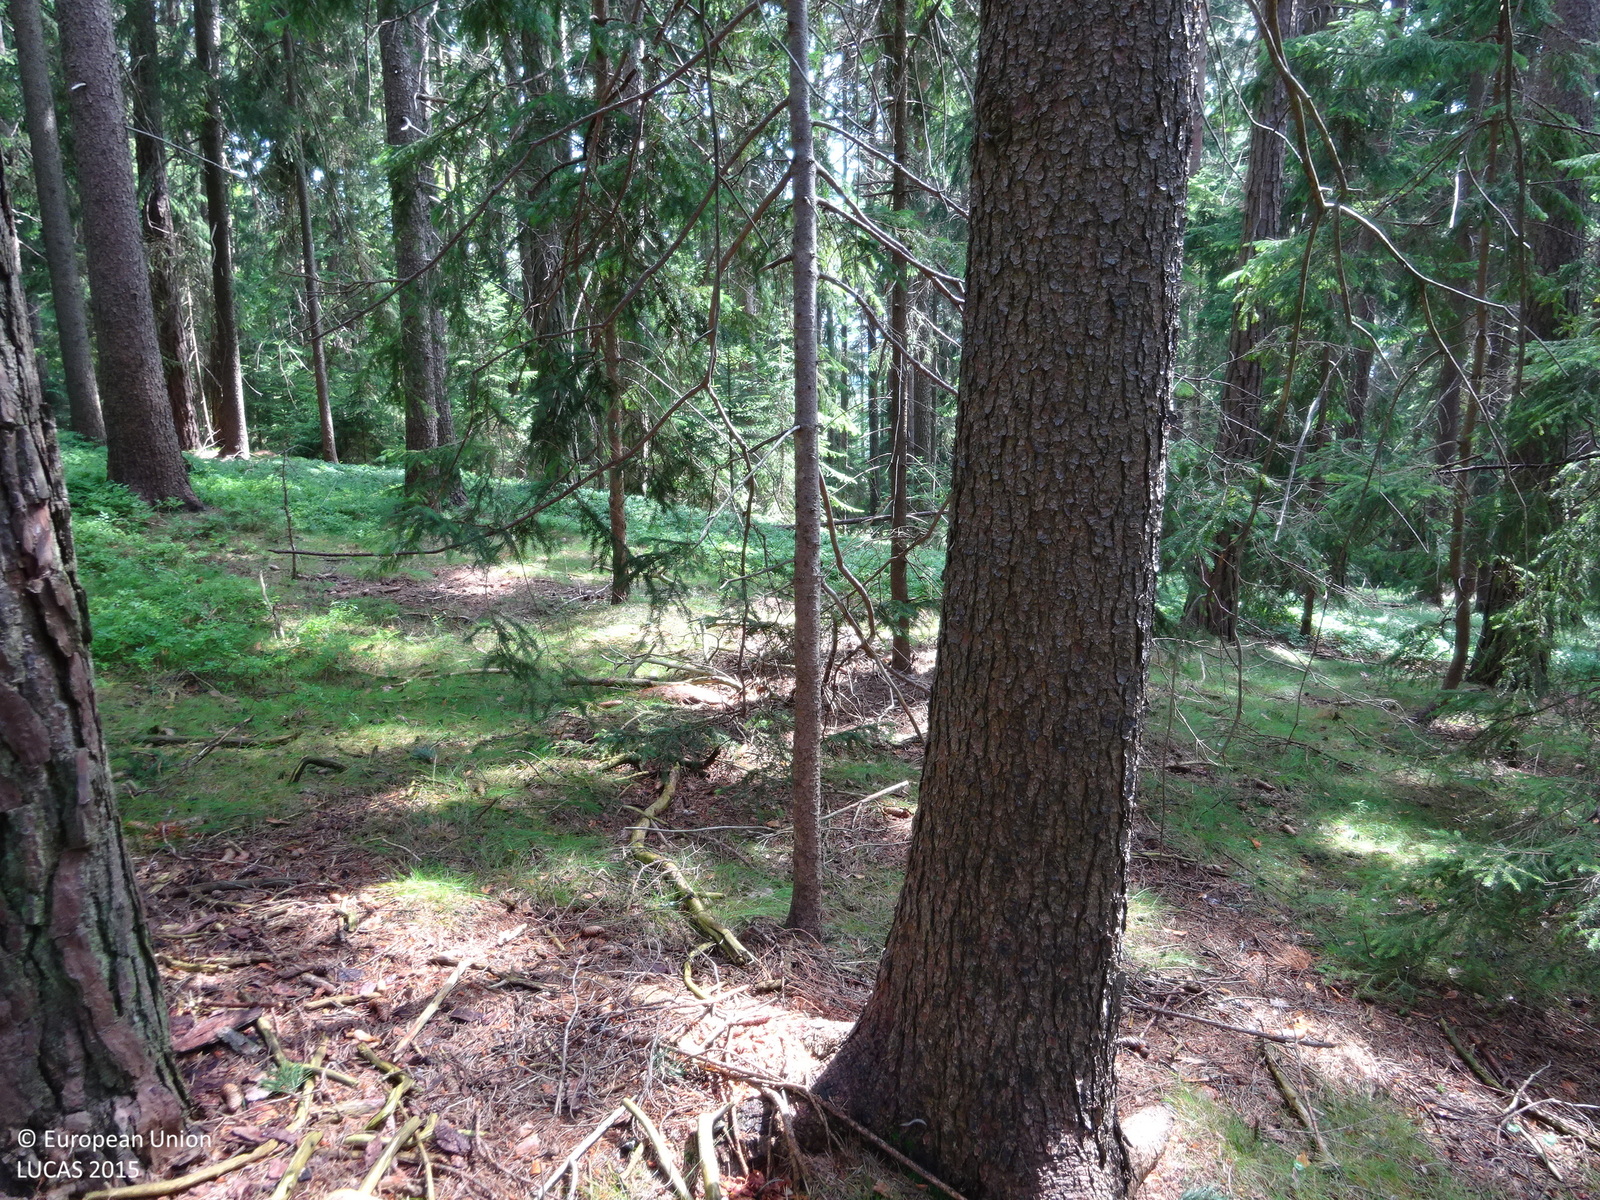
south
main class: Woodland
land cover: Spruce dominated coniferous woodland
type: alpine coniferous forest
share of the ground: > 75 %
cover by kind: coniferous forest trees 80 %, shrubs 10 %, herbaceous plants 10 %
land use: Forestry
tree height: > 5 m
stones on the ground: < 10 %
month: July
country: AT
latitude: 47.2240
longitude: 15.4280
